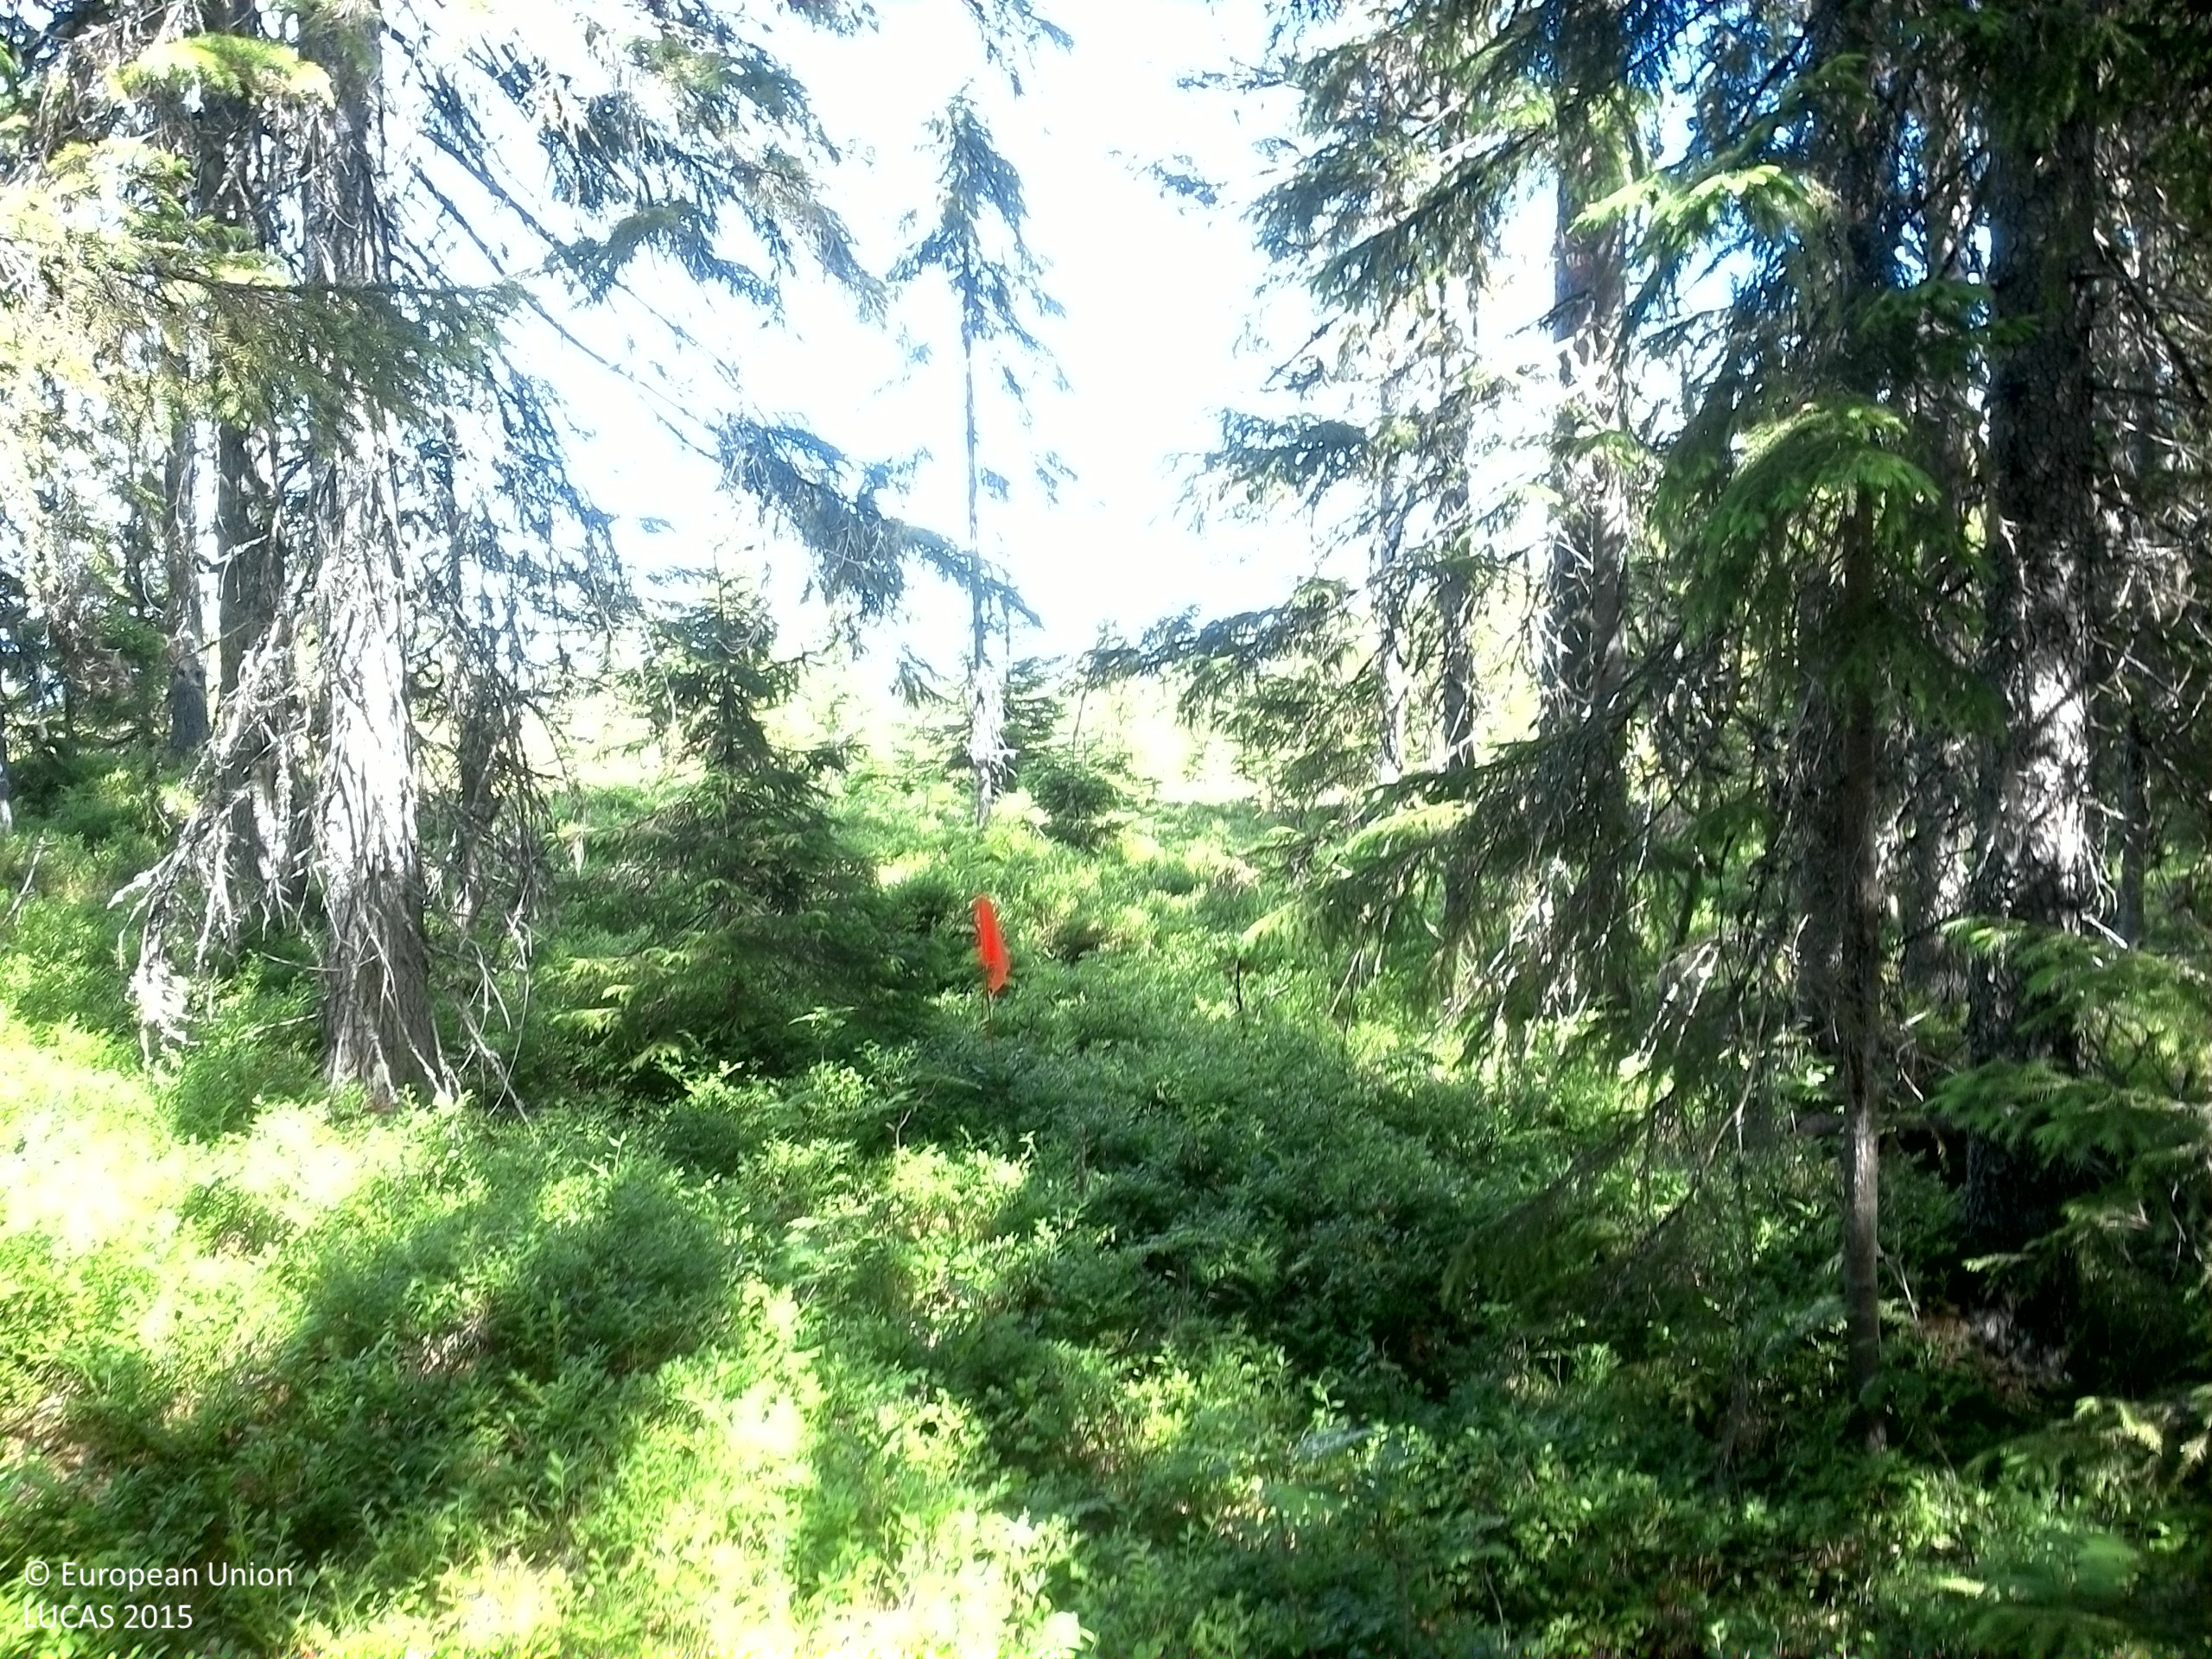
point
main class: Woodland
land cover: Spruce dominated coniferous woodland
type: boreal forest
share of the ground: 50 - 75 %
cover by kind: coniferous forest trees 60 %, shrubs 30 %, broadleaved forest trees 10 %
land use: Forestry
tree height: > 5 m
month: June
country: SE
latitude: 62.8485
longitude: 17.7371
